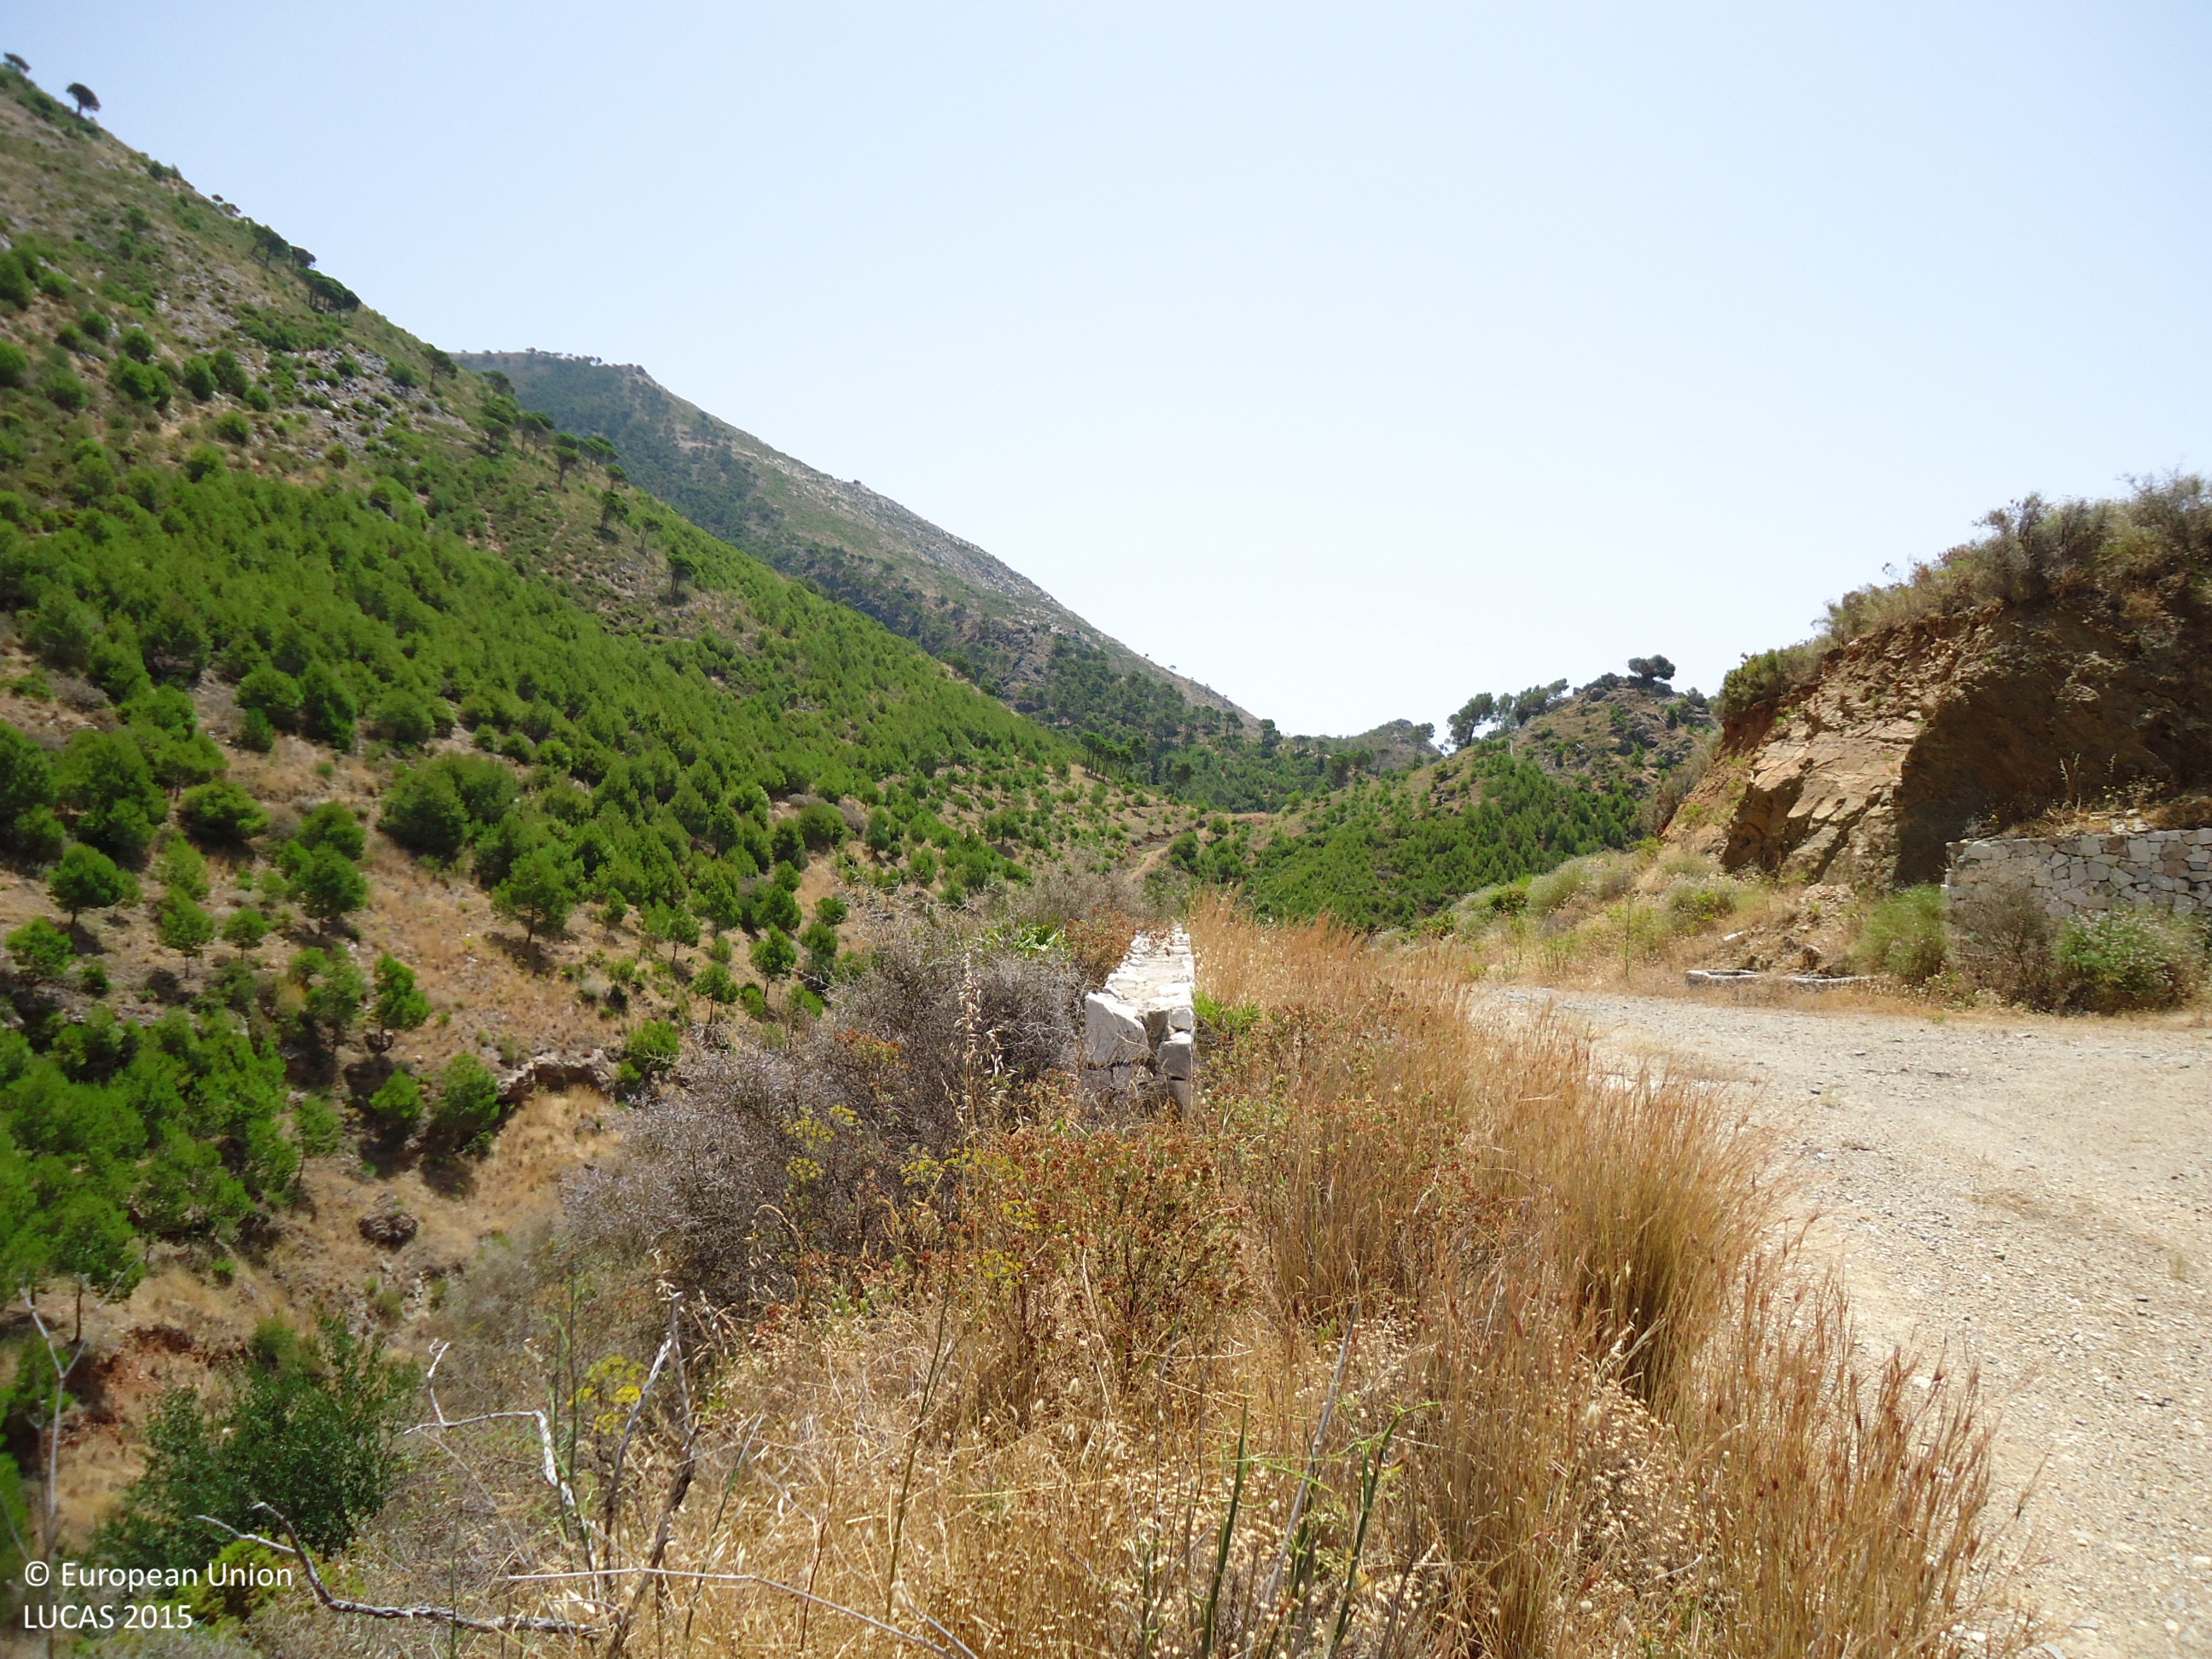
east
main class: Shrubland
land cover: Shrubland with sparse tree cover
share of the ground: > 75 %
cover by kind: shrubs 95 %, coniferous forest trees 5 %
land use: Semi-natural and natural areas not in use
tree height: > 5 m
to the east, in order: Shrubland with sparse tree cover
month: June
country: ES
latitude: 36.6033
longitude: -4.6688
